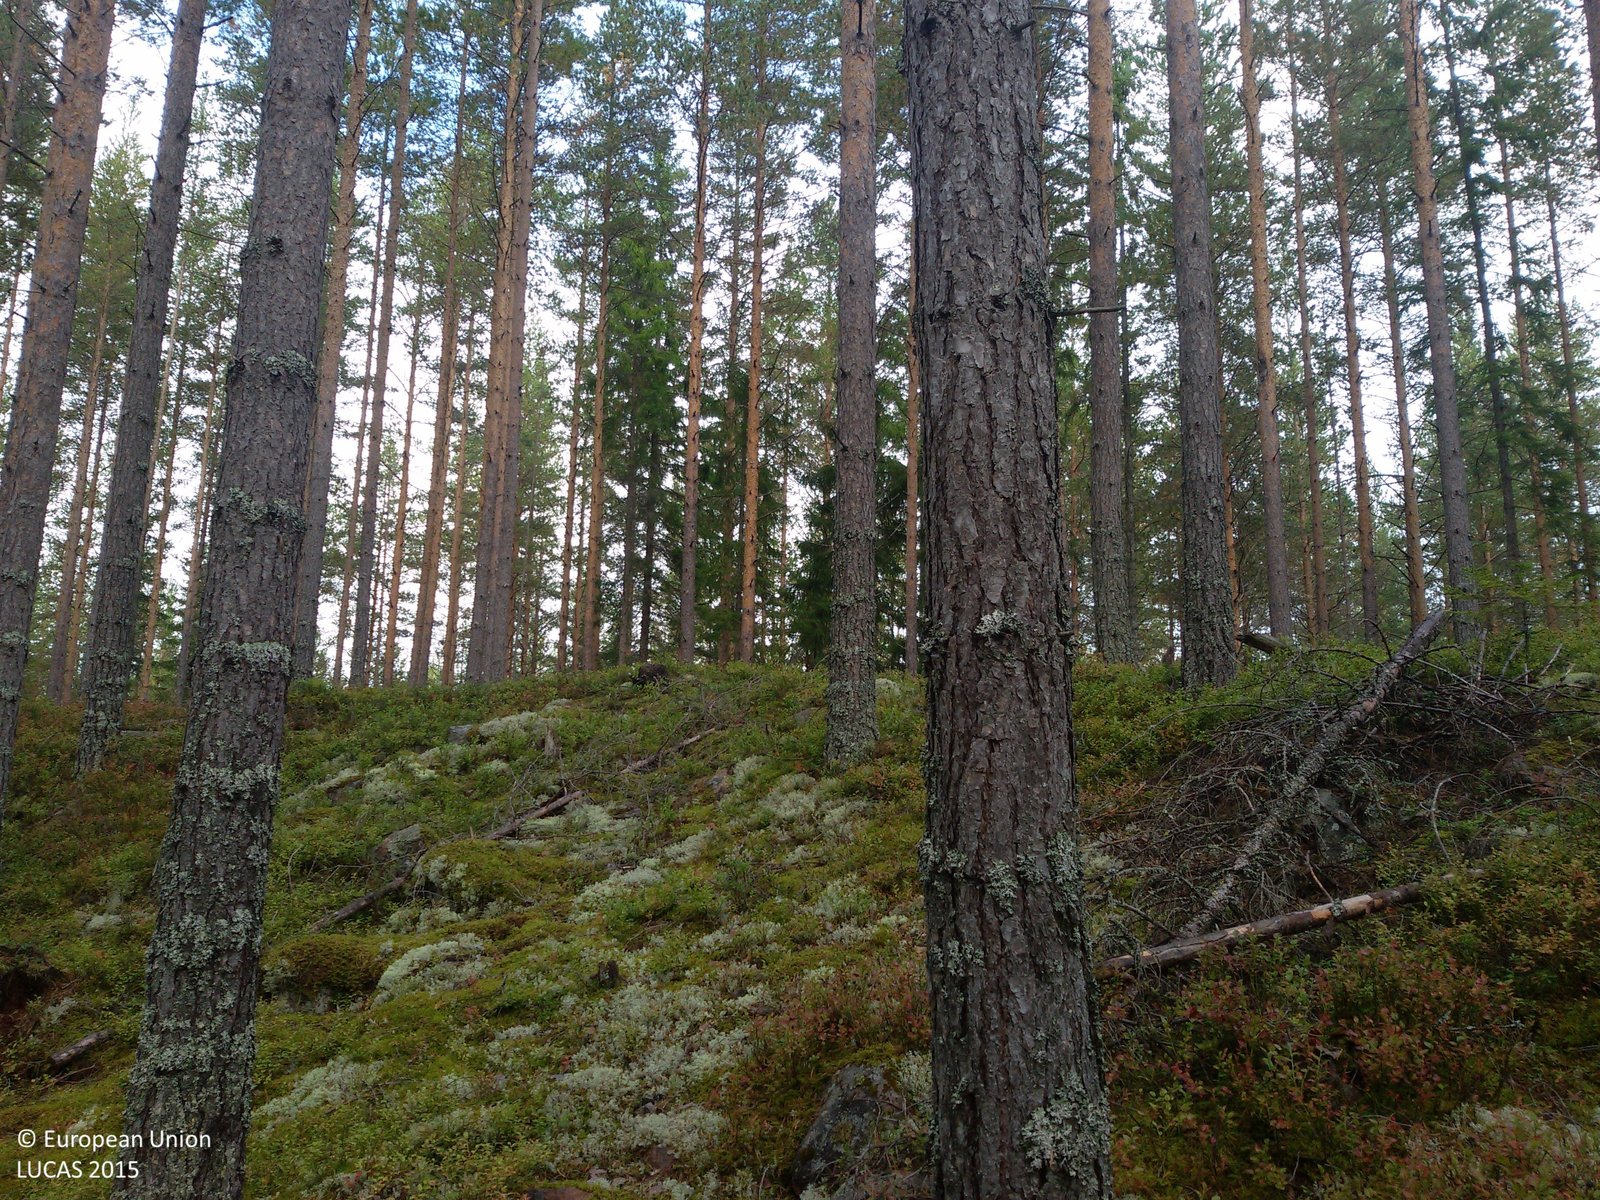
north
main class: Woodland
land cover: Pine dominated coniferous woodland
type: boreal forest
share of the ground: 50 - 75 %
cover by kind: coniferous forest trees 70 %, shrubs 20 %, lichens and mosses 10 %
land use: Forestry
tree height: > 5 m
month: September
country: SE
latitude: 60.8462
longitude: 14.5692
